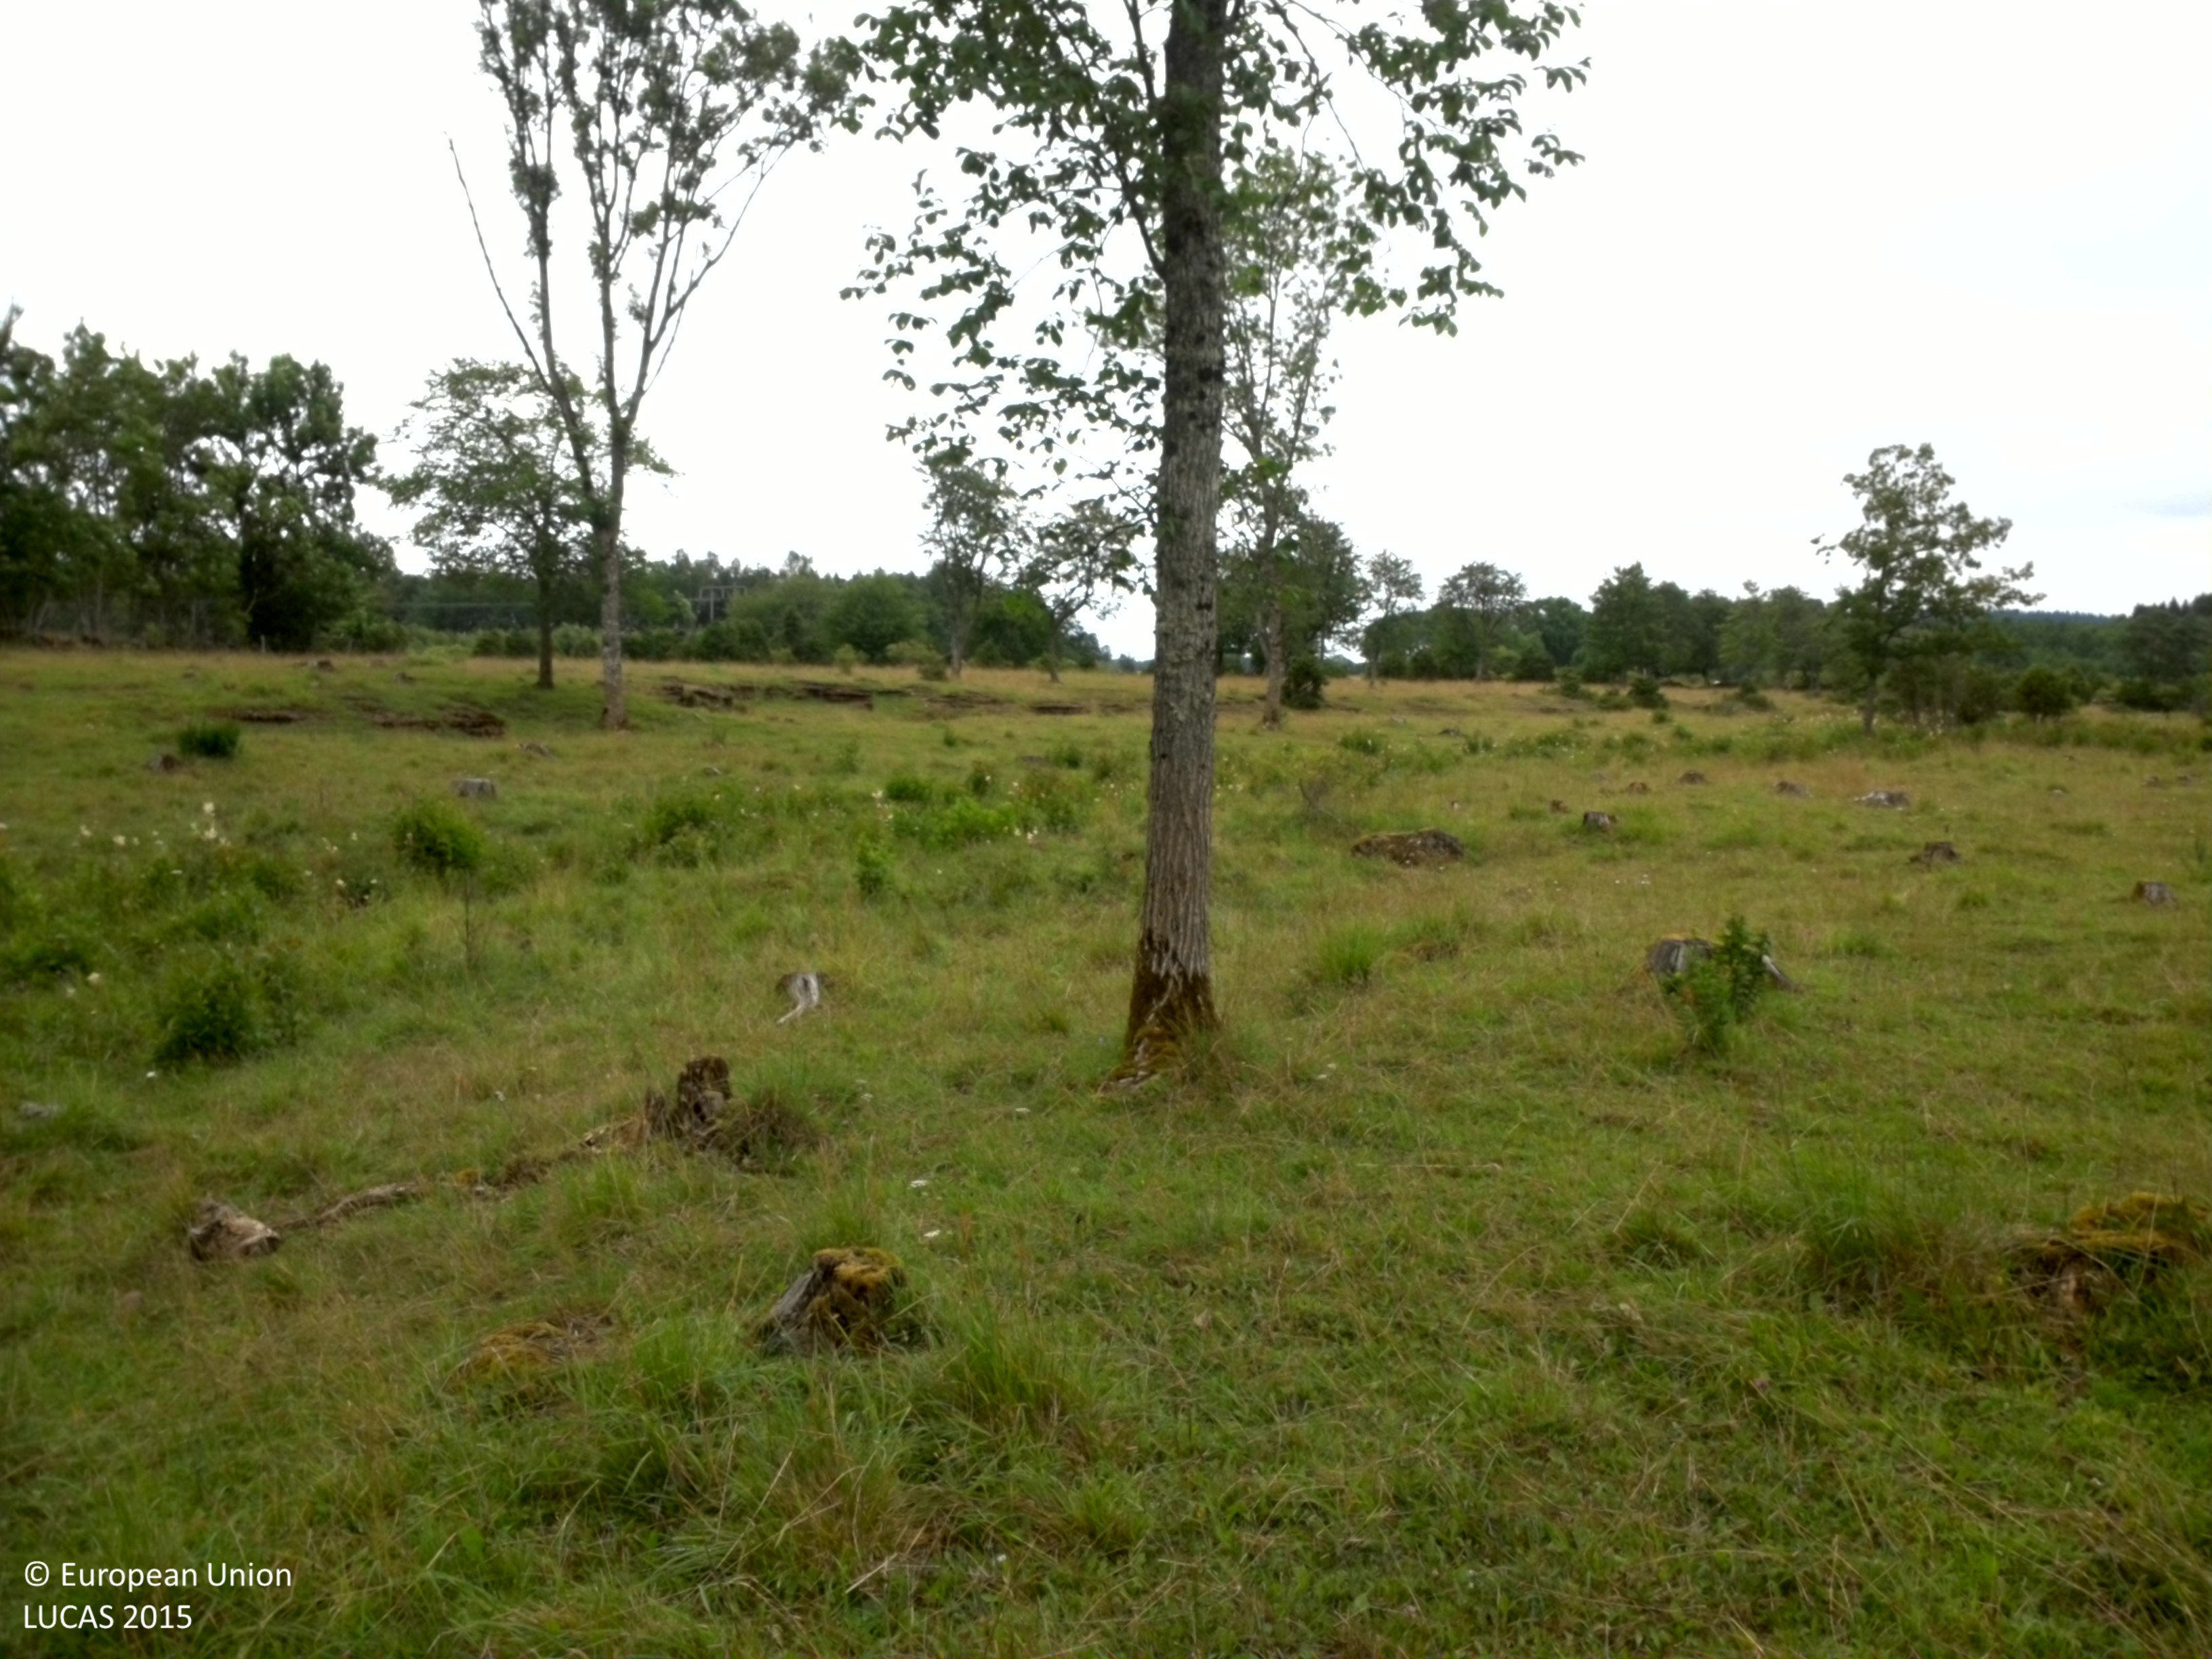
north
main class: Grassland
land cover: Grassland with sparse tree/shrub cover
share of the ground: > 75 %
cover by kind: herbaceous plants 90 %, broadleaved forest trees 5 %, shrubs 5 %
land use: Agriculture (excluding fallow land and kitchen gardens)
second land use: Amenities, museums, leisure
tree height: > 5 m
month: July
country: SE
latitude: 58.5731
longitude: 13.3812
